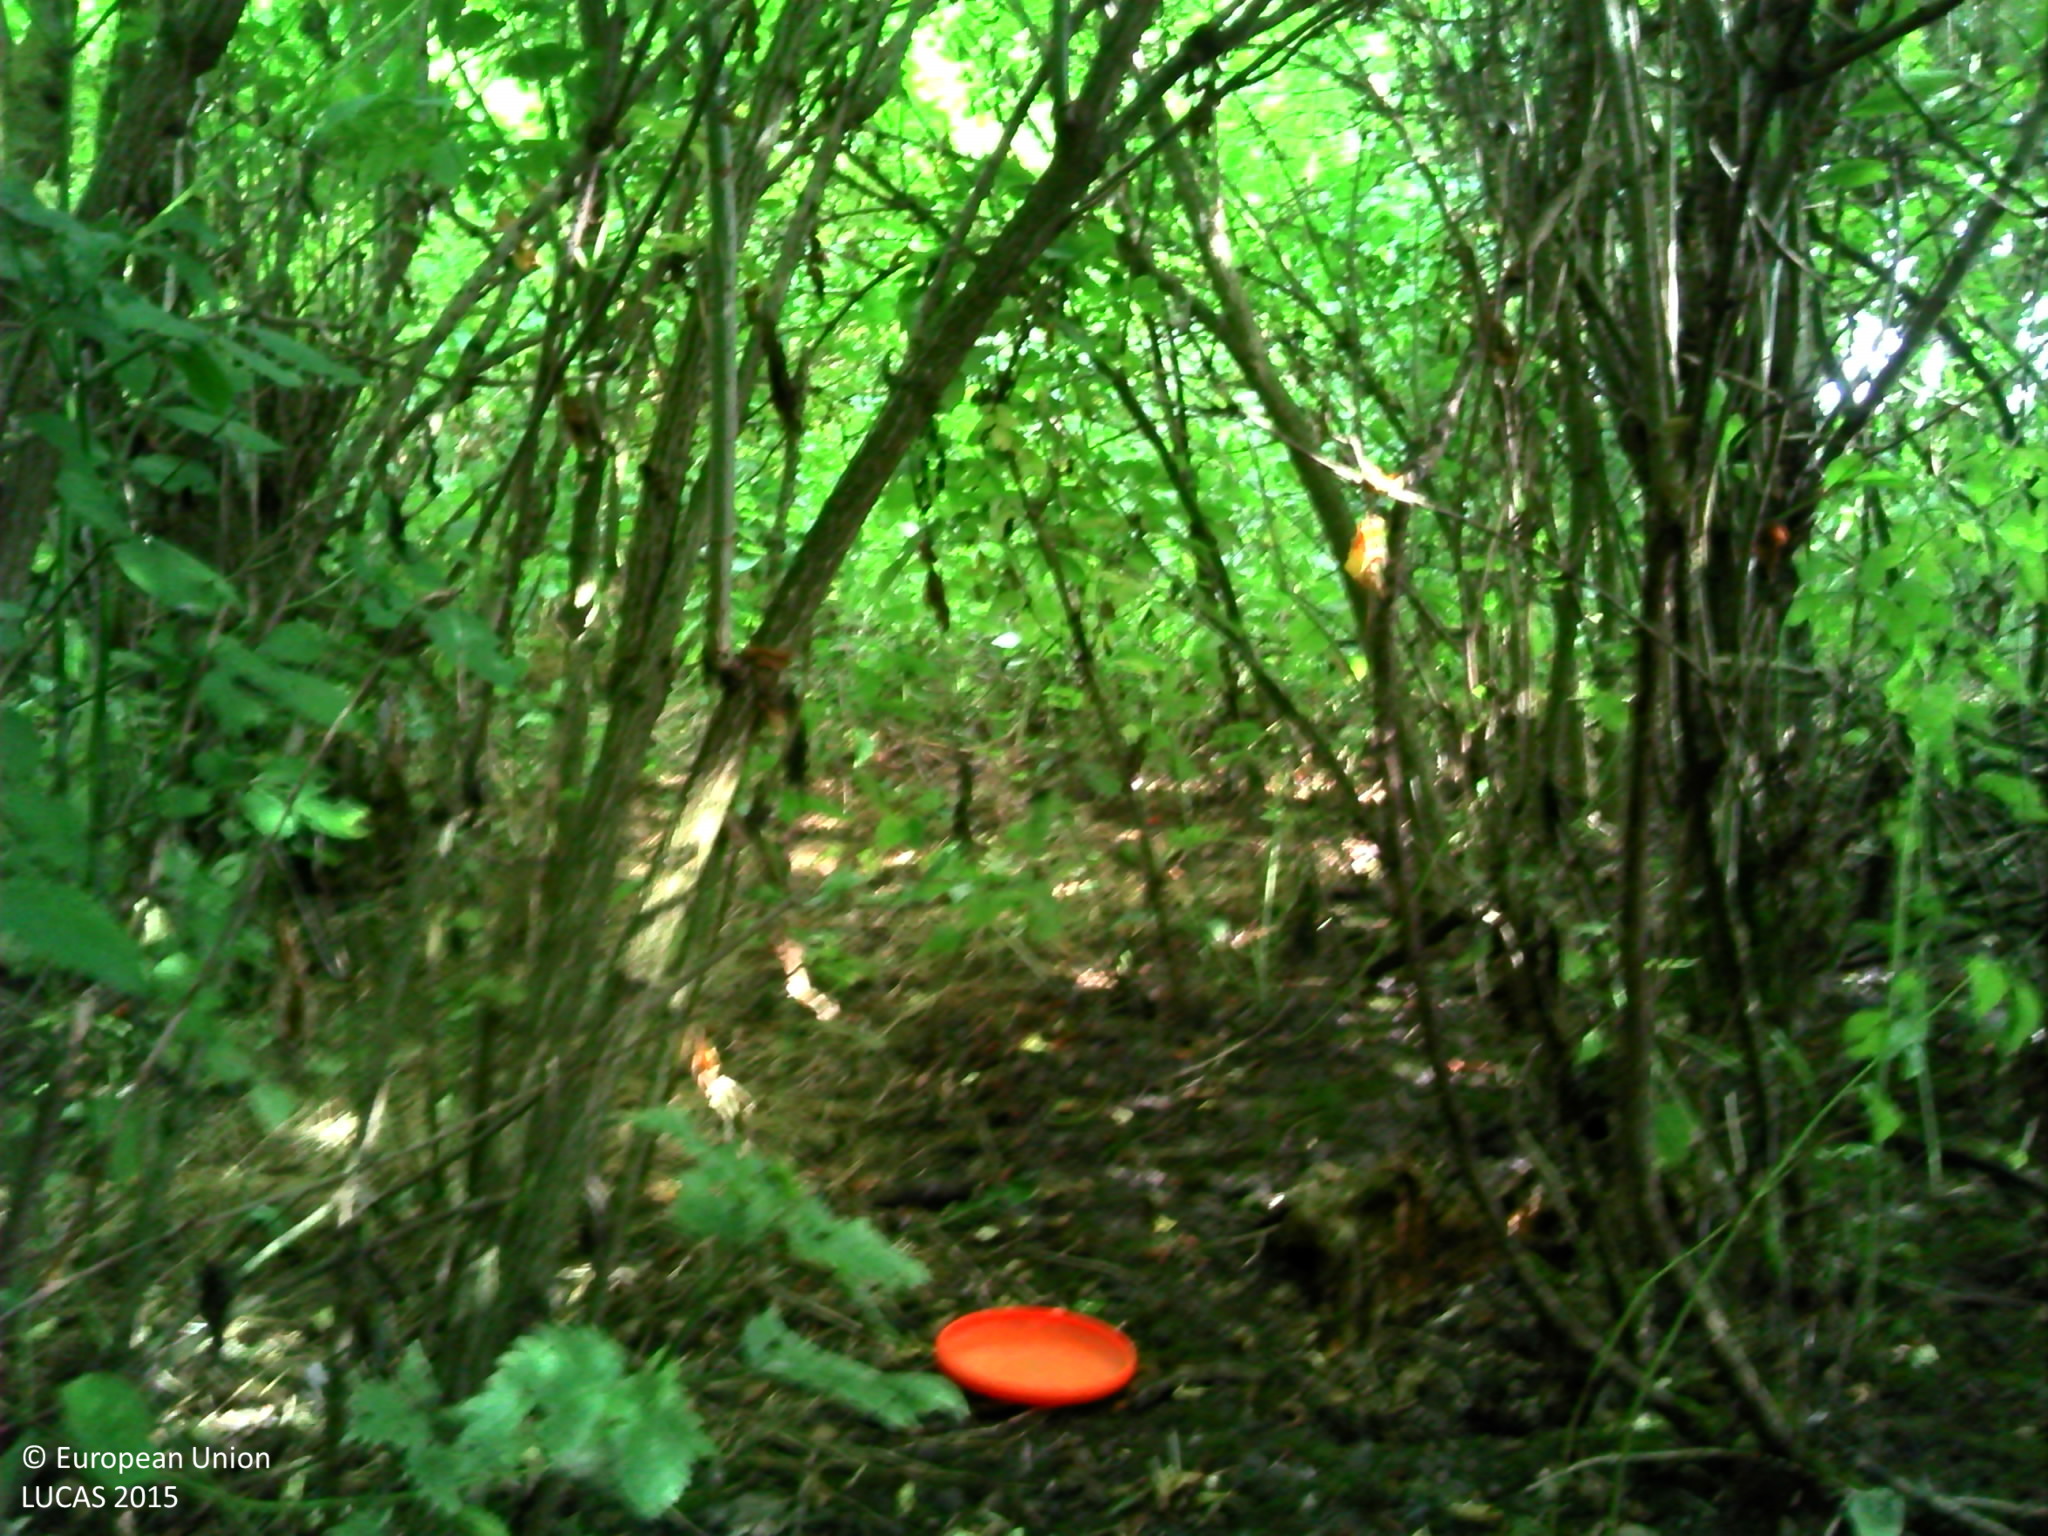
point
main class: Woodland
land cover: Broadleaved woodland
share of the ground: > 75 %
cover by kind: broadleaved forest trees 60 %, shrubs 20 %, herbaceous plants 5 %
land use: Semi-natural and natural areas not in use
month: August
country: FR
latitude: 50.8992
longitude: 2.0360
